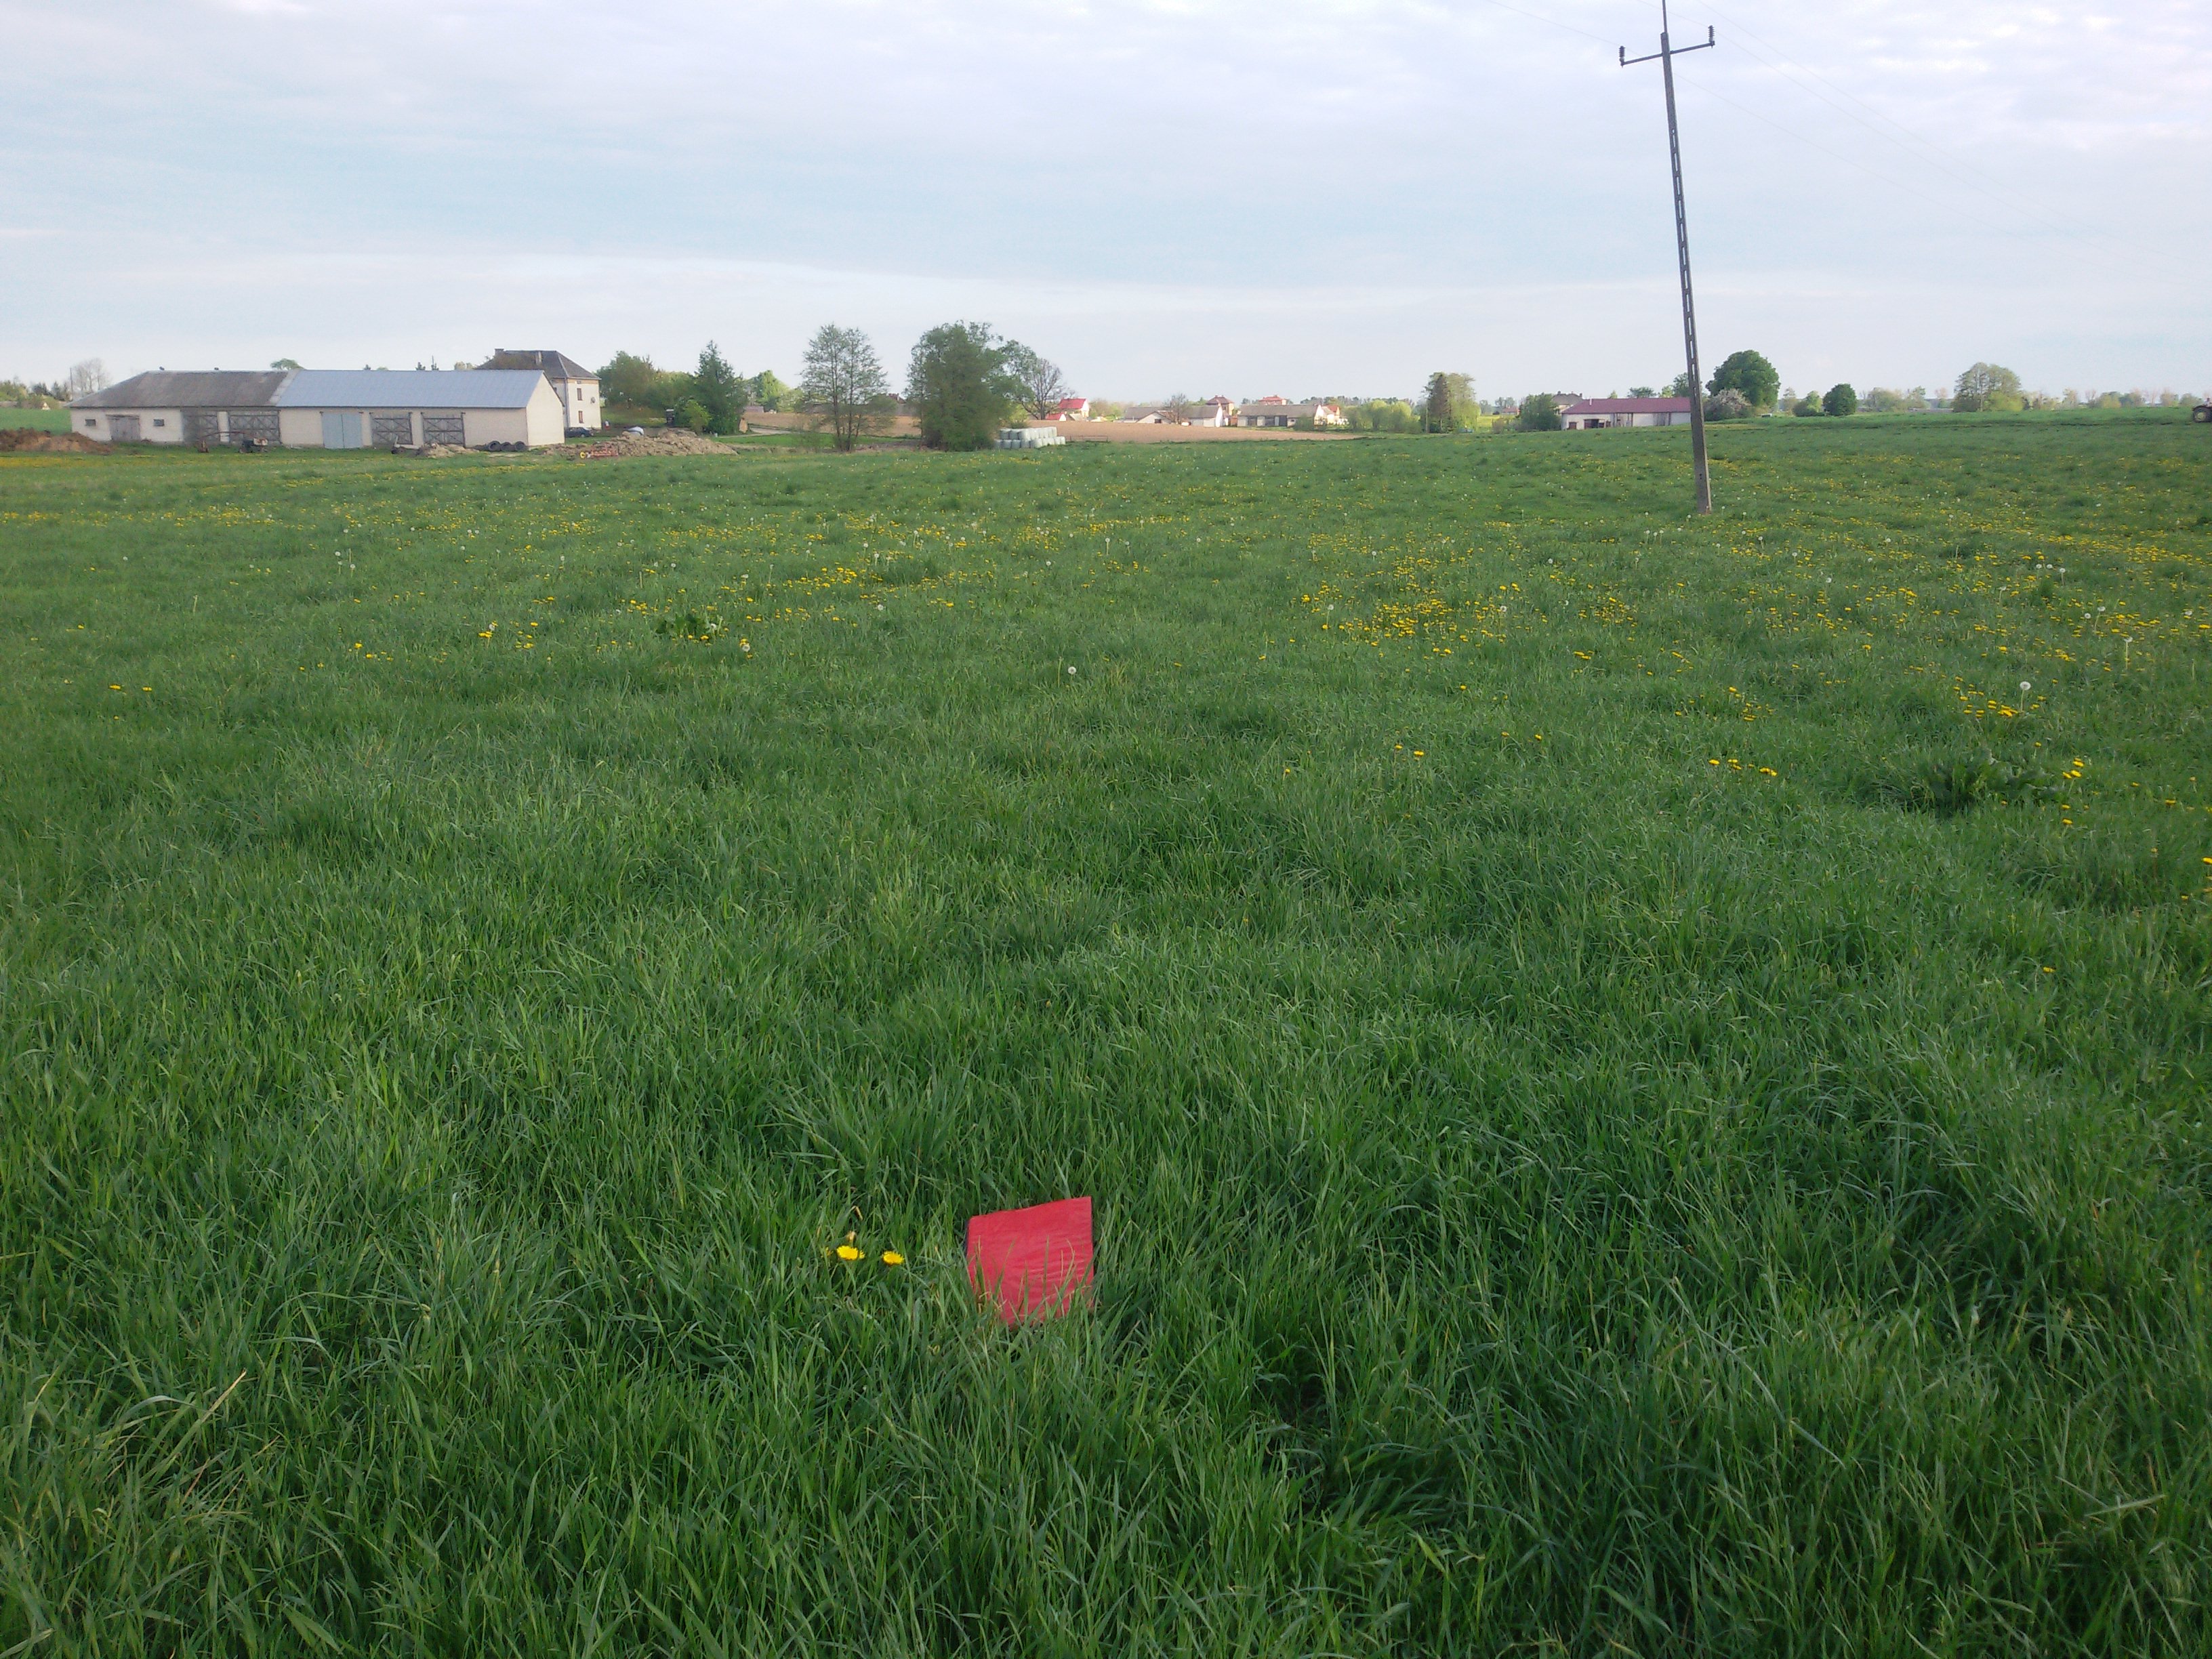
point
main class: Grassland
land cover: Grassland without tree/shrub cover
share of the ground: > 75 %
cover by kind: herbaceous plants 100 %
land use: Agriculture (excluding fallow land and kitchen gardens)
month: May
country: PL
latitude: 52.9642
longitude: 22.3765
